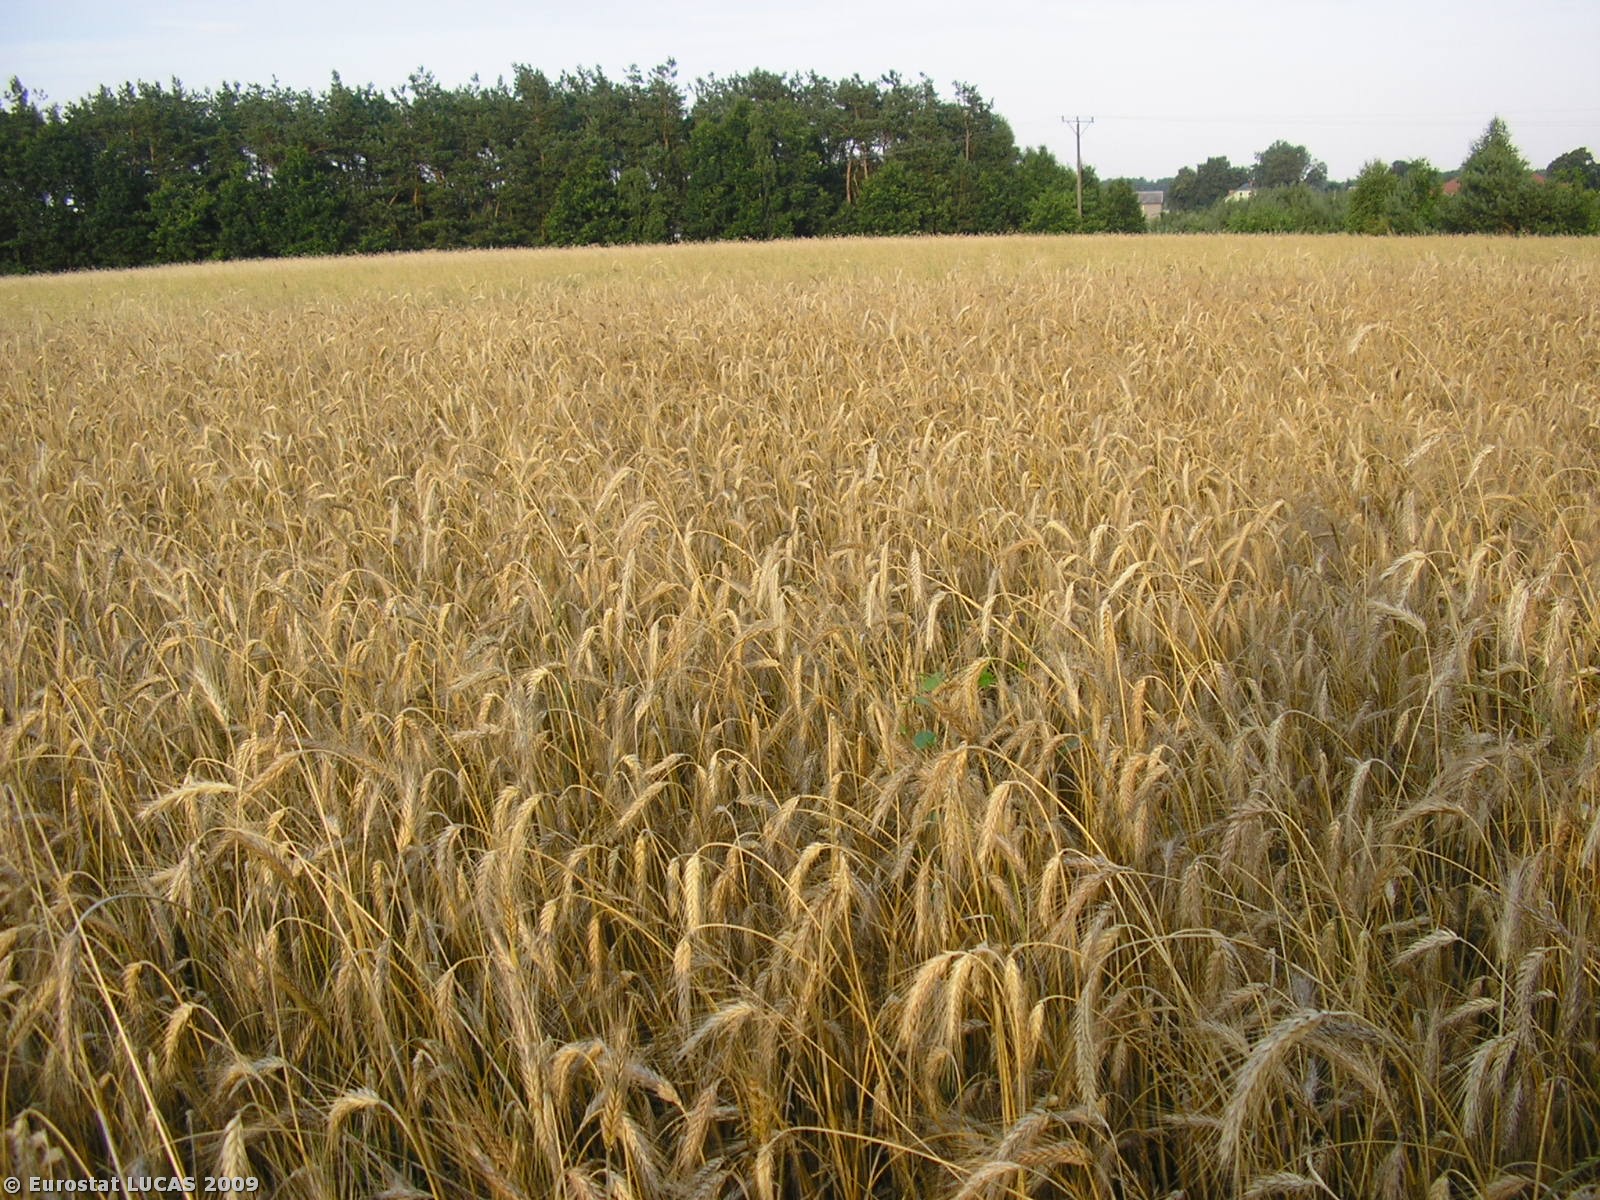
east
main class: Cropland
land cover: Rye
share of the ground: > 75 %
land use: Agriculture (excluding fallow land and kitchen gardens)
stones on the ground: < 10 %
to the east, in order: Rye; Grass margins; Oats; Grass margins; Rye; Grass margins; Oats; Grass margins; Tracks; Grass margins; Rye; Coniferous woodland; Electric lines; Coniferous woodland; Rye; Tracks; Oats
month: July
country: PL
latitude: 52.1303
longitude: 22.1714
